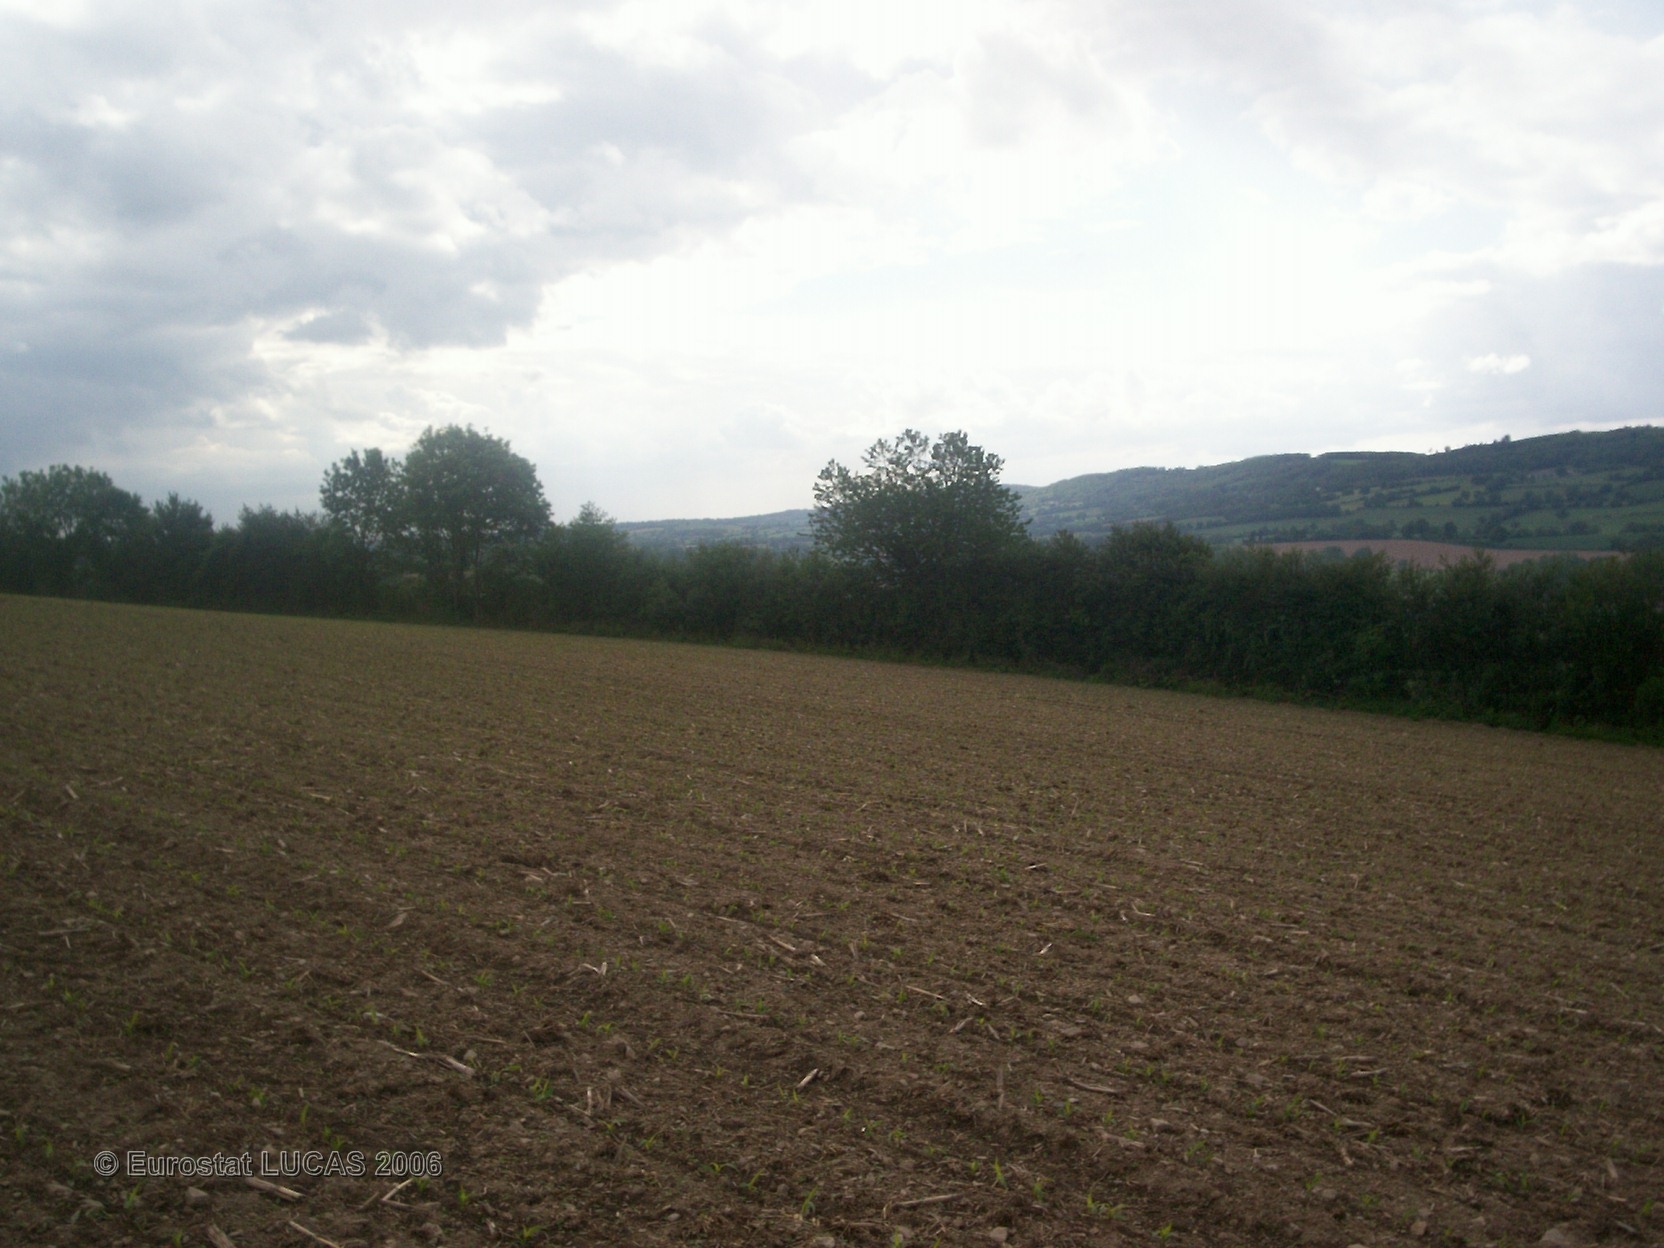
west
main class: Cropland
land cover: Maize
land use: Agriculture (excluding fallow land and kitchen gardens)
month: May
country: FR
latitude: 48.1808
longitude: -0.2392
